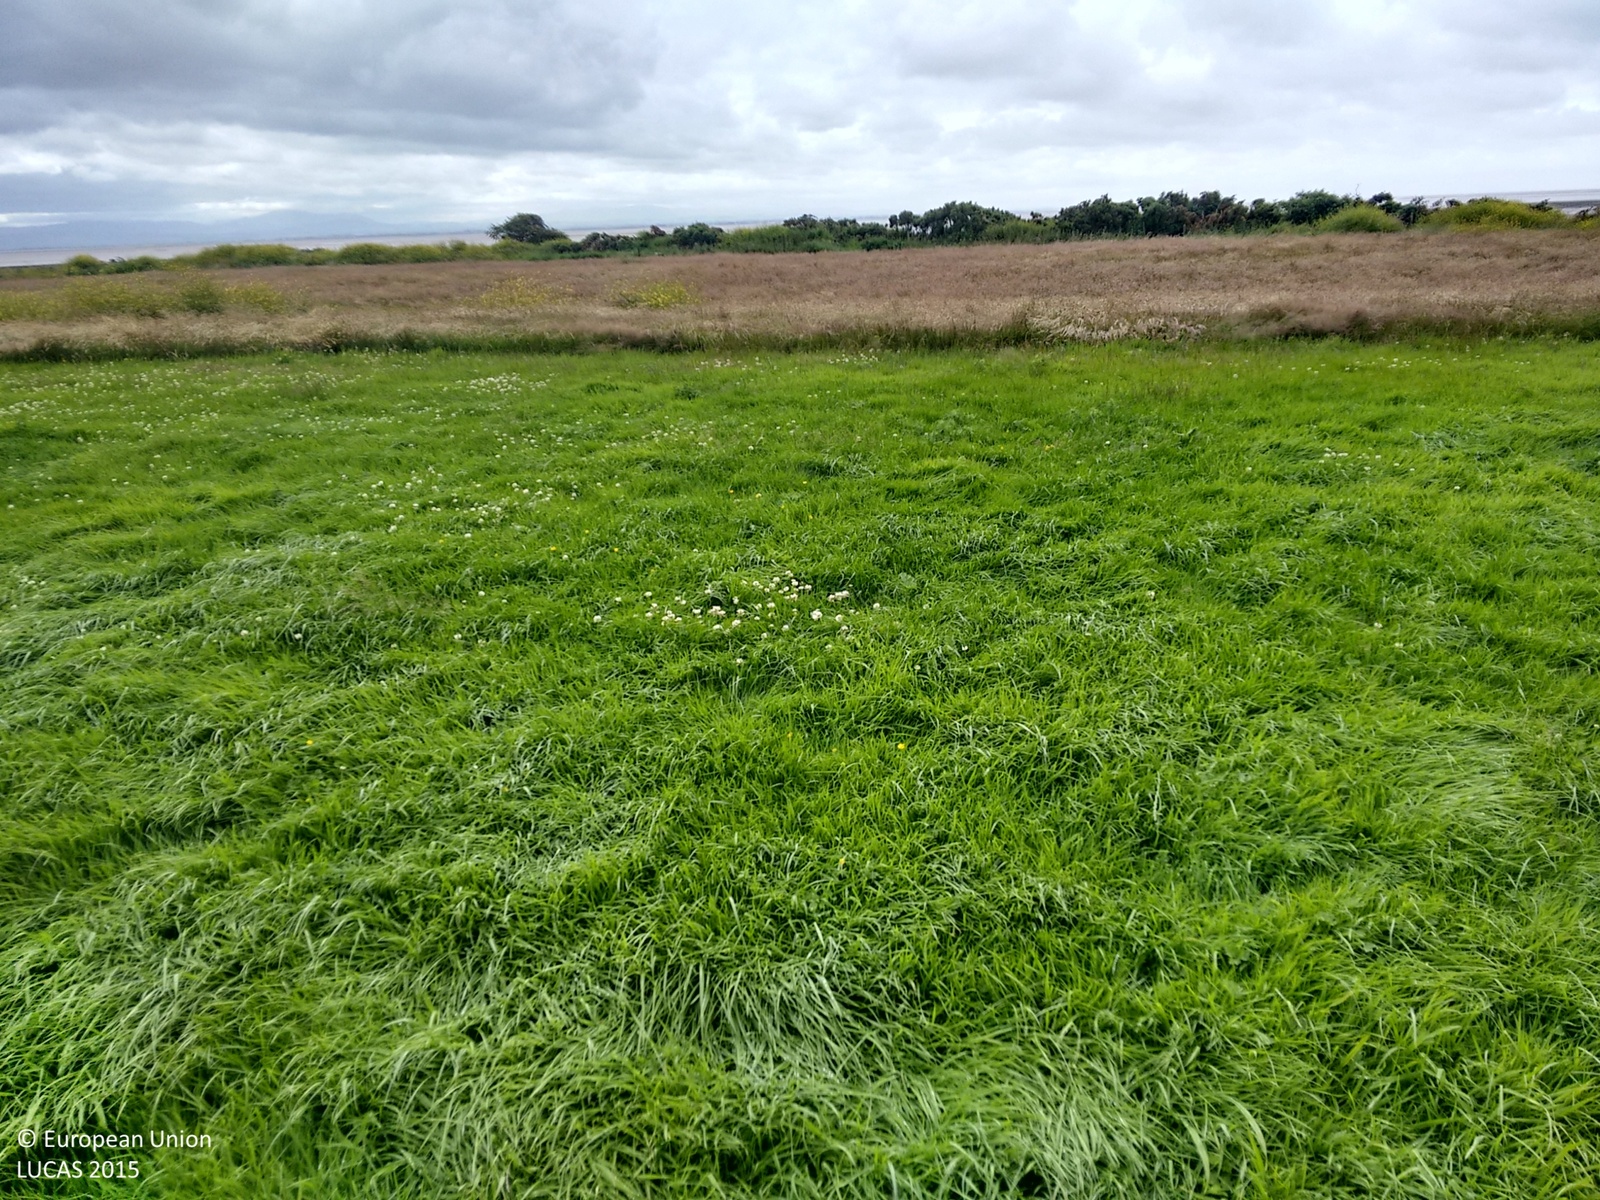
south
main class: Grassland
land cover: Grassland without tree/shrub cover
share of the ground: > 75 %
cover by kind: herbaceous plants 100 %
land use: Agriculture (excluding fallow land and kitchen gardens)
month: July
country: GB
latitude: 54.9725
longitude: -3.3728
